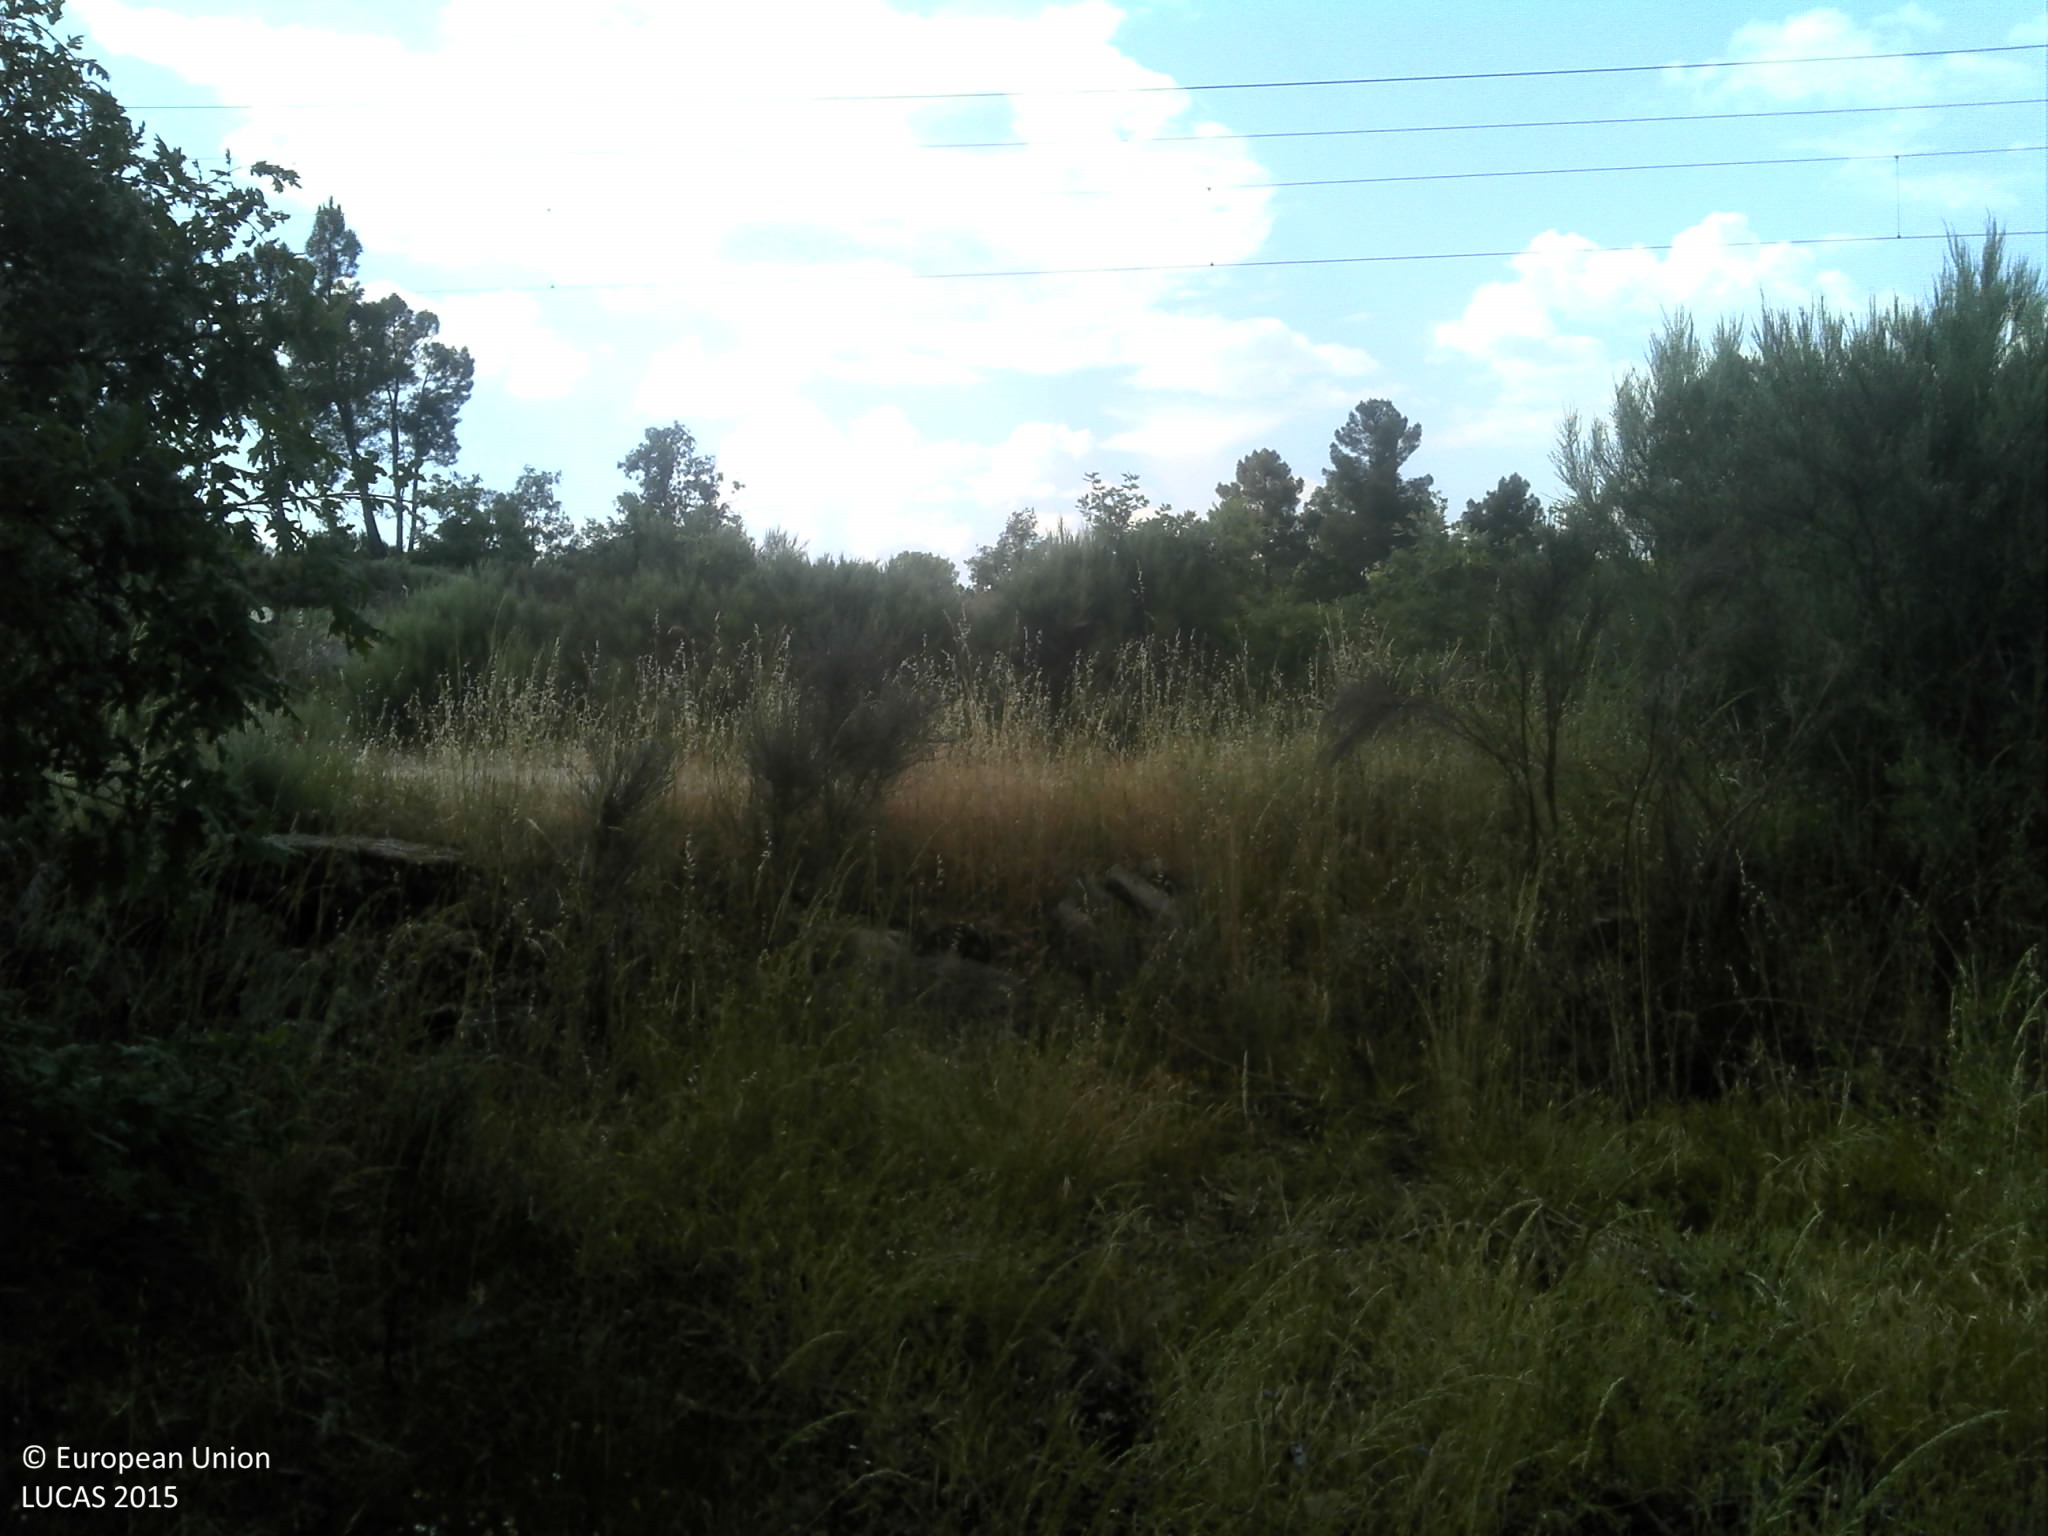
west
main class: Grassland
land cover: Grassland without tree/shrub cover
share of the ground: 50 - 75 %
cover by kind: herbaceous plants 75 %, unconsolidated bare surface 20 %, shrubs 5 %
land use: Agriculture (excluding fallow land and kitchen gardens)
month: June
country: PT
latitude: 40.5002
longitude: -7.1290
